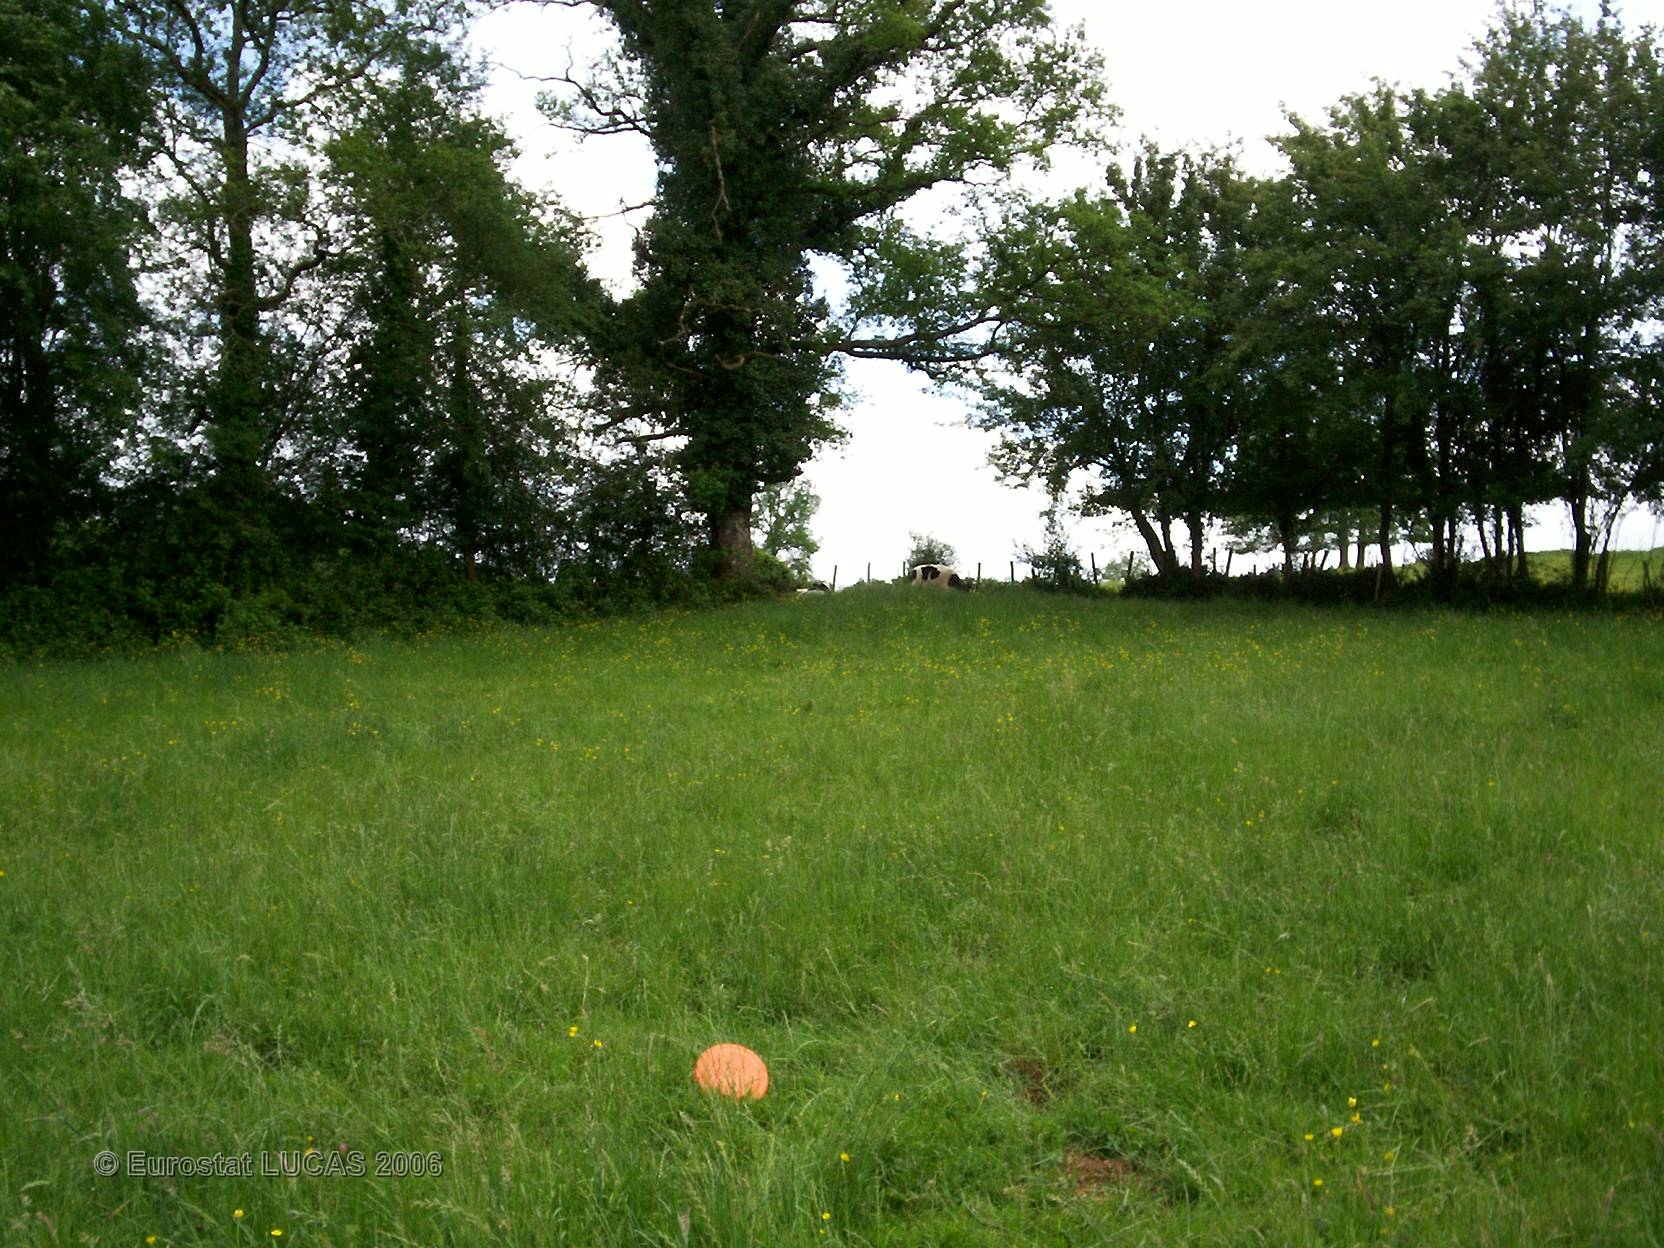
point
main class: Grassland
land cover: Grassland without tree/shrub cover
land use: Agriculture (excluding fallow land and kitchen gardens)
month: May
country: FR
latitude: 45.8210
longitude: 0.5255
